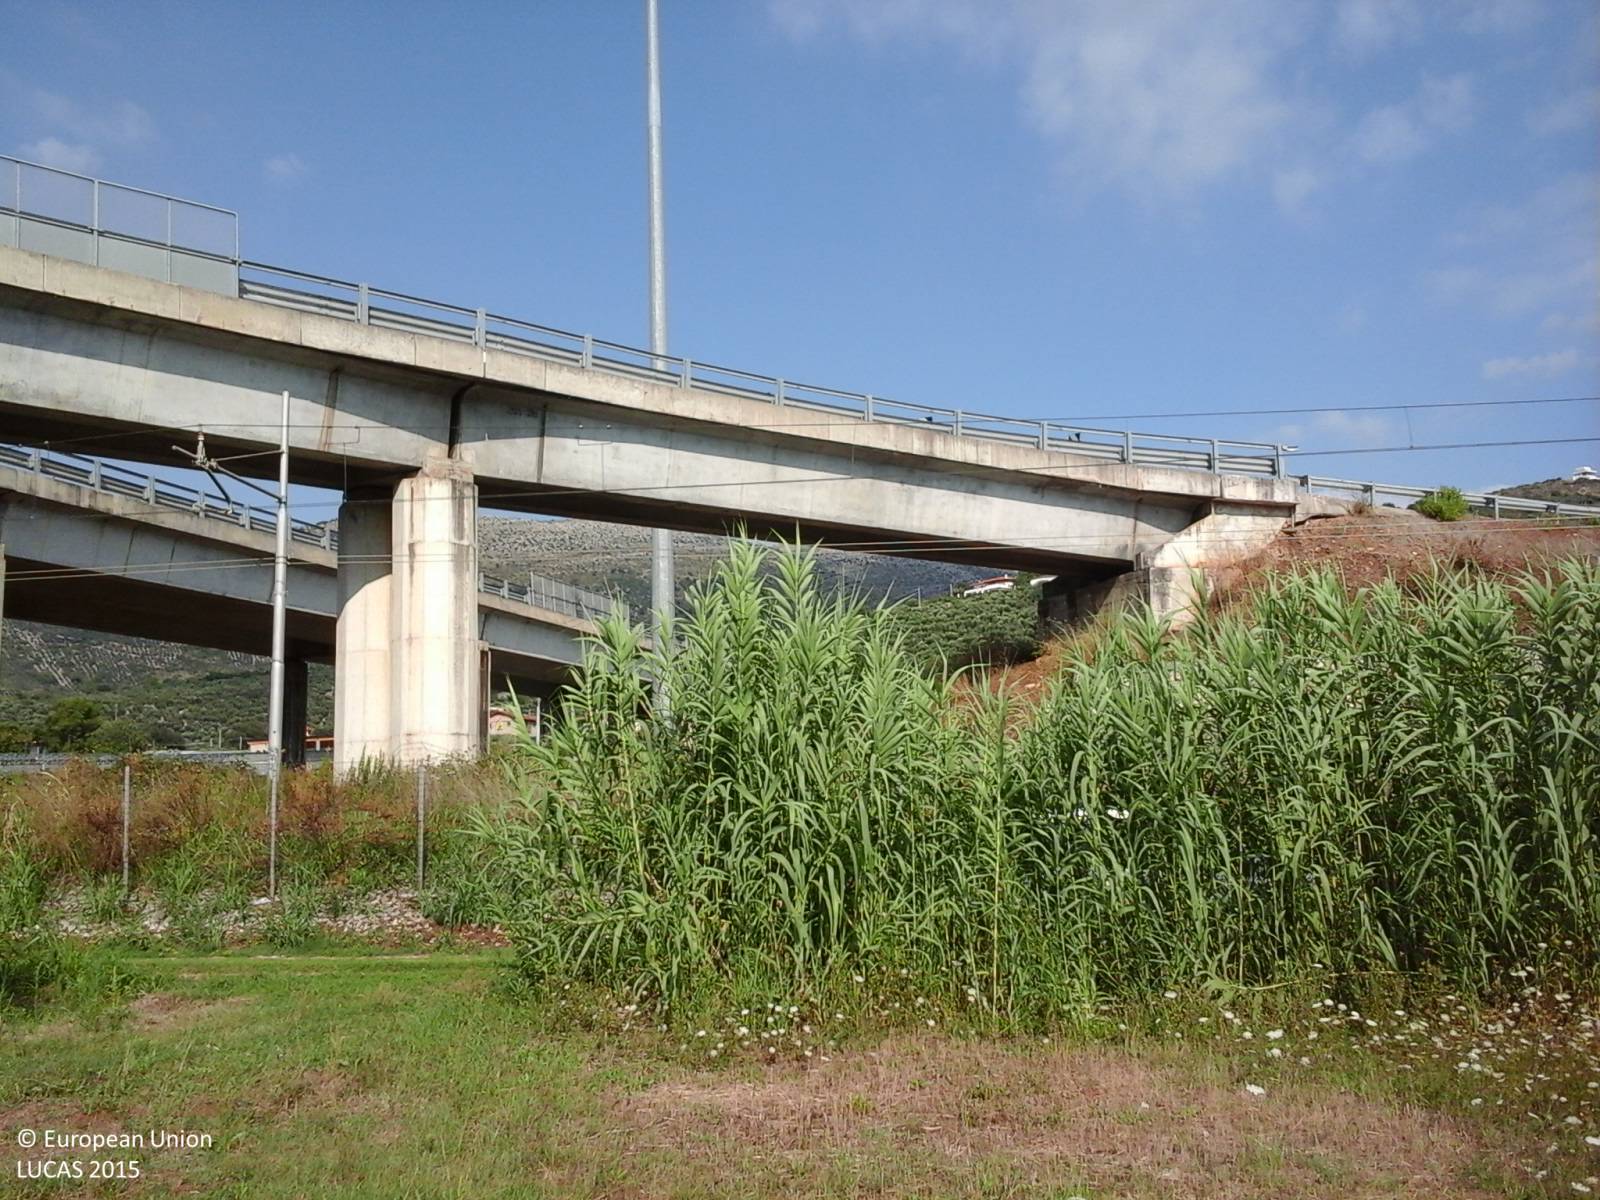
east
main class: Grassland
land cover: Spontaneously vegetated surfaces
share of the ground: > 75 %
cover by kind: herbaceous plants 100 %
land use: Agriculture (excluding fallow land and kitchen gardens)
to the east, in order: Spontaneously vegetated surfaces; Shruby margins; Ditches and canals; Tracks; Grass margins; Railways; Grass margins; Fences; Grassland without tree/shrub cover; Paved roads, cycling and walking lanes; Grassland without tree/shrub cover; Paved roads, cycling and walking lanes; Grassland without tree/shrub cover; Paved roads, cycling and walking lanes; Grassland without tree/shrub cover; Ditches and canals; Grass margins; Paved roads, cycling and walking lanes; Grass margins; Olive groves
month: August
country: IT
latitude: 41.3918
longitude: 13.2043
